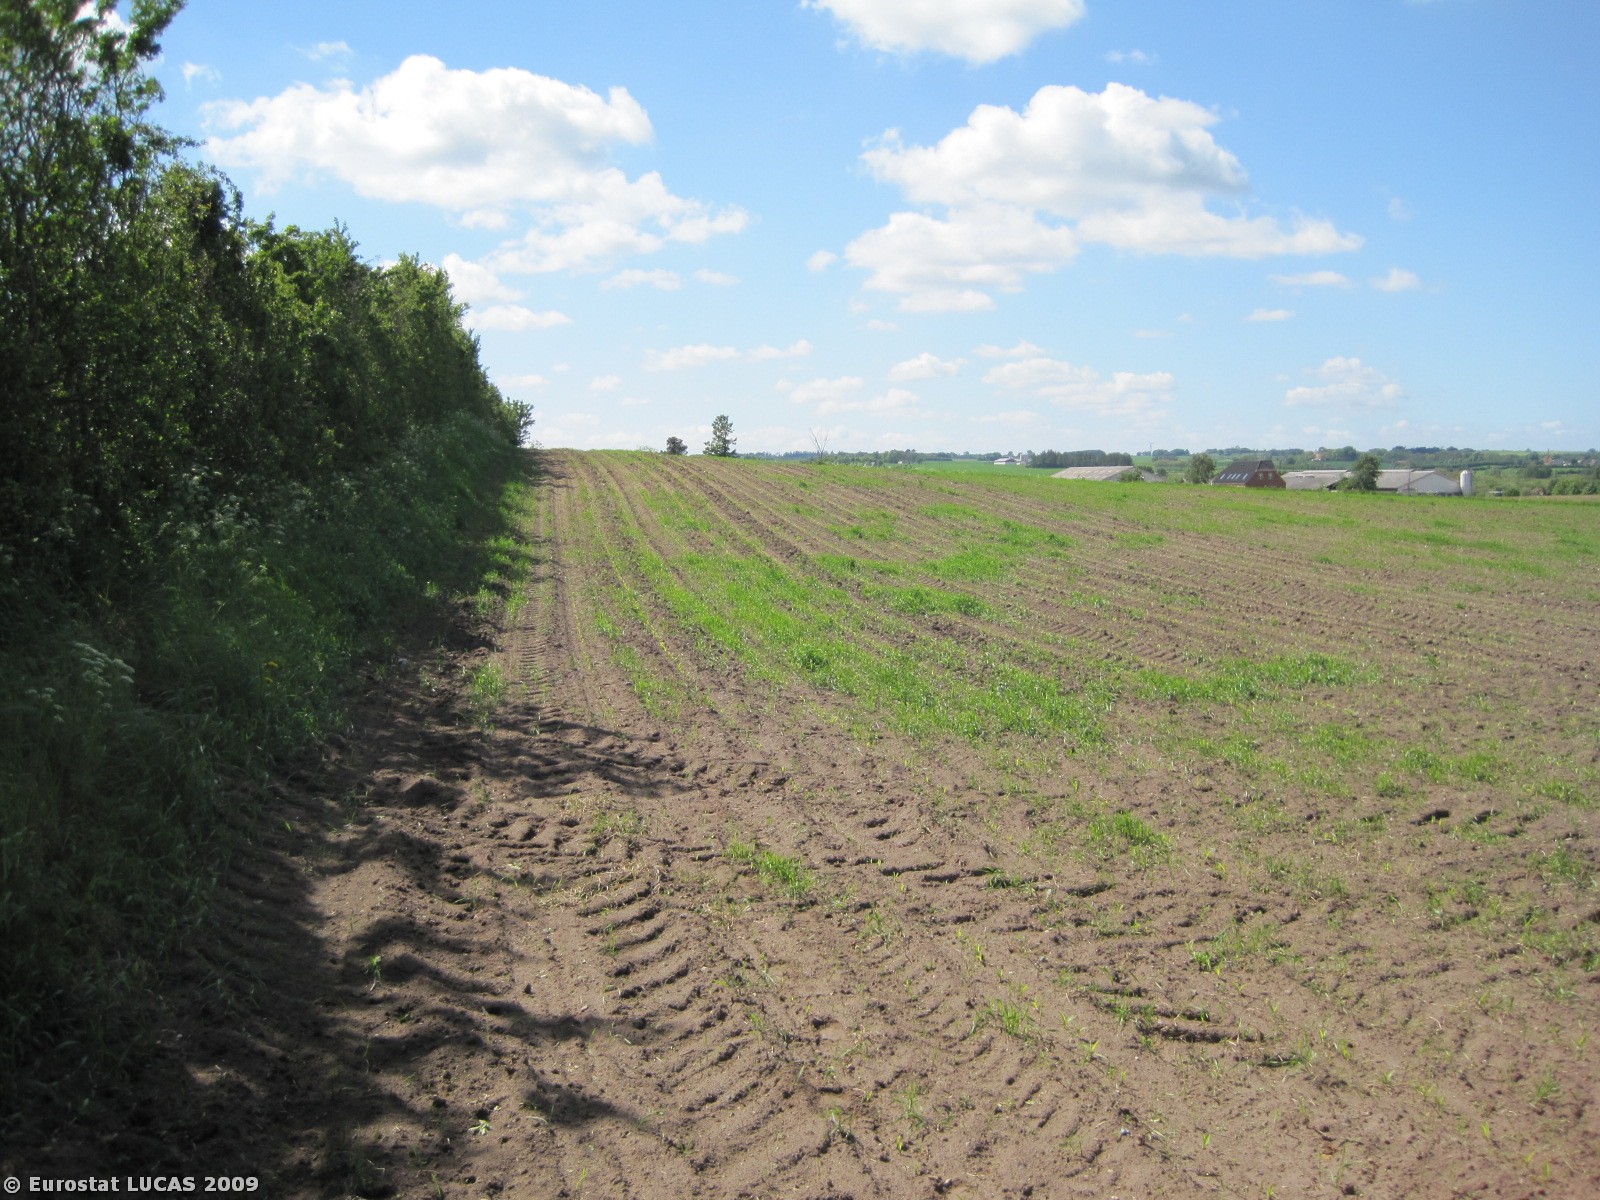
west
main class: Cropland
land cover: Maize
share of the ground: 10 - 25 %
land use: Agriculture (excluding fallow land and kitchen gardens)
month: May
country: DK
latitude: 56.8349
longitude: 10.0491
